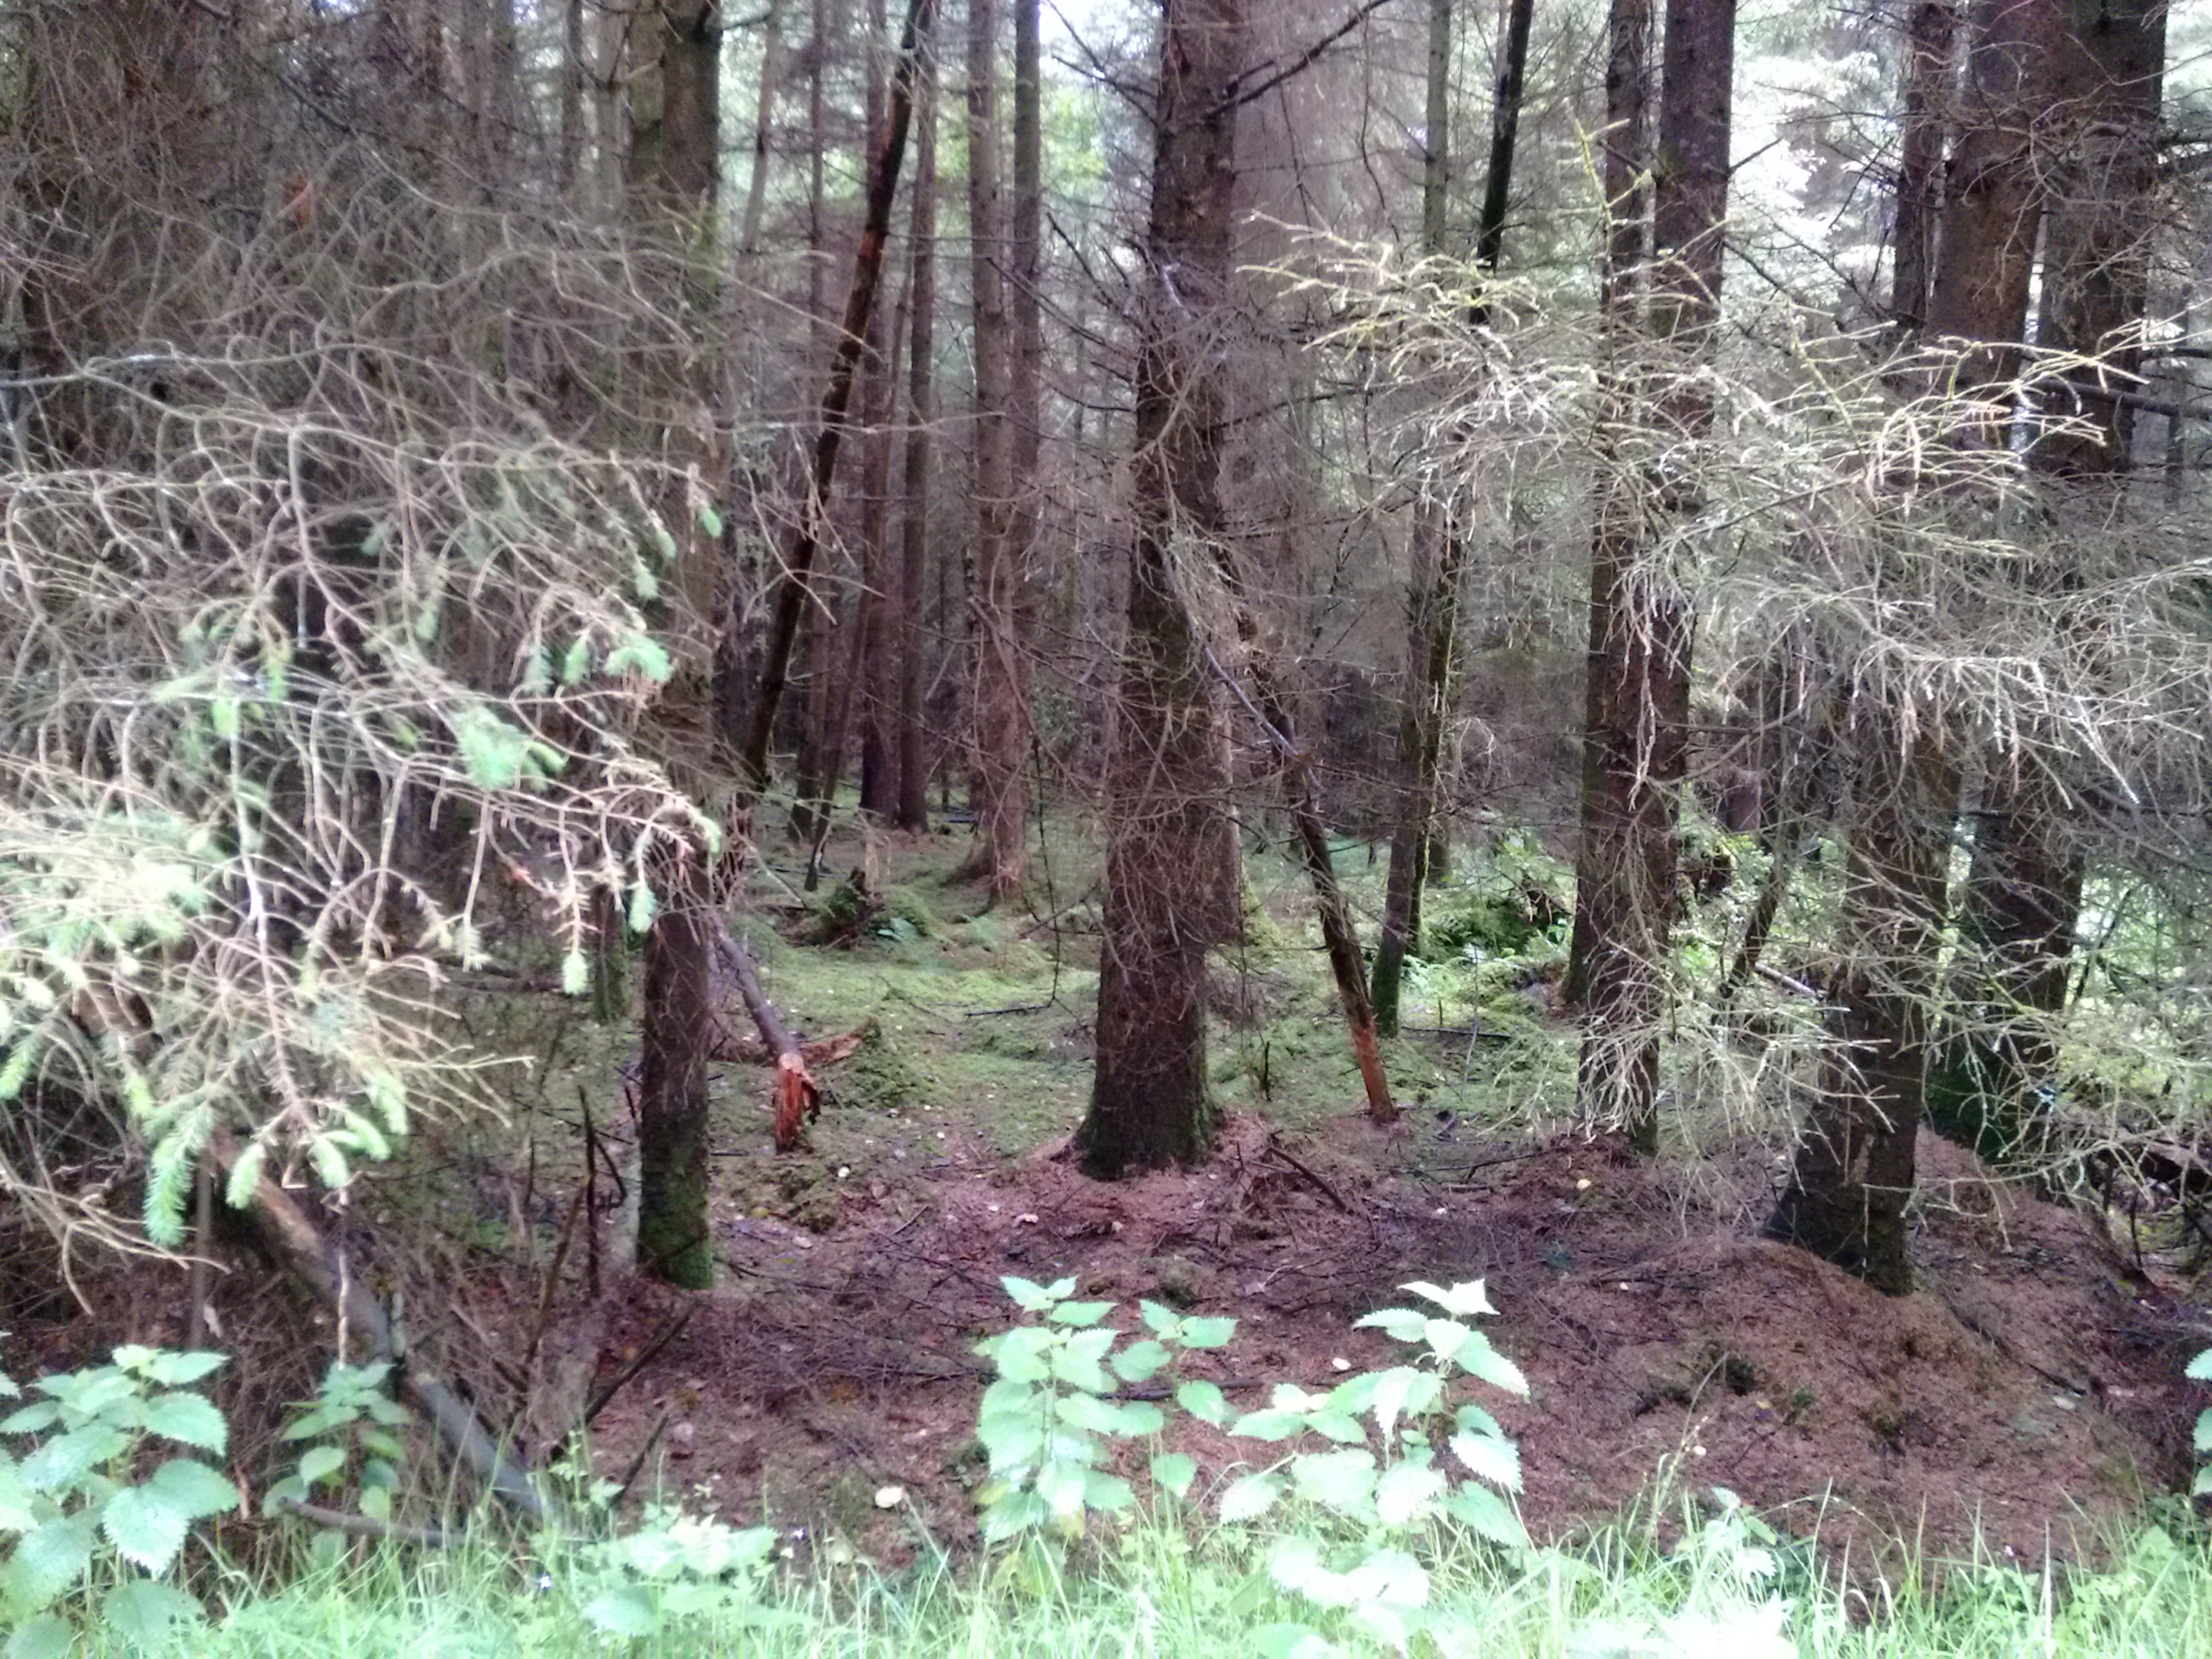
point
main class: Woodland
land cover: Spruce dominated coniferous woodland
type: exotic forest
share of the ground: > 75 %
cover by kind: coniferous forest trees 100 %
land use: Forestry
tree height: > 5 m
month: July
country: GB
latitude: 54.4040
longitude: -7.0725
